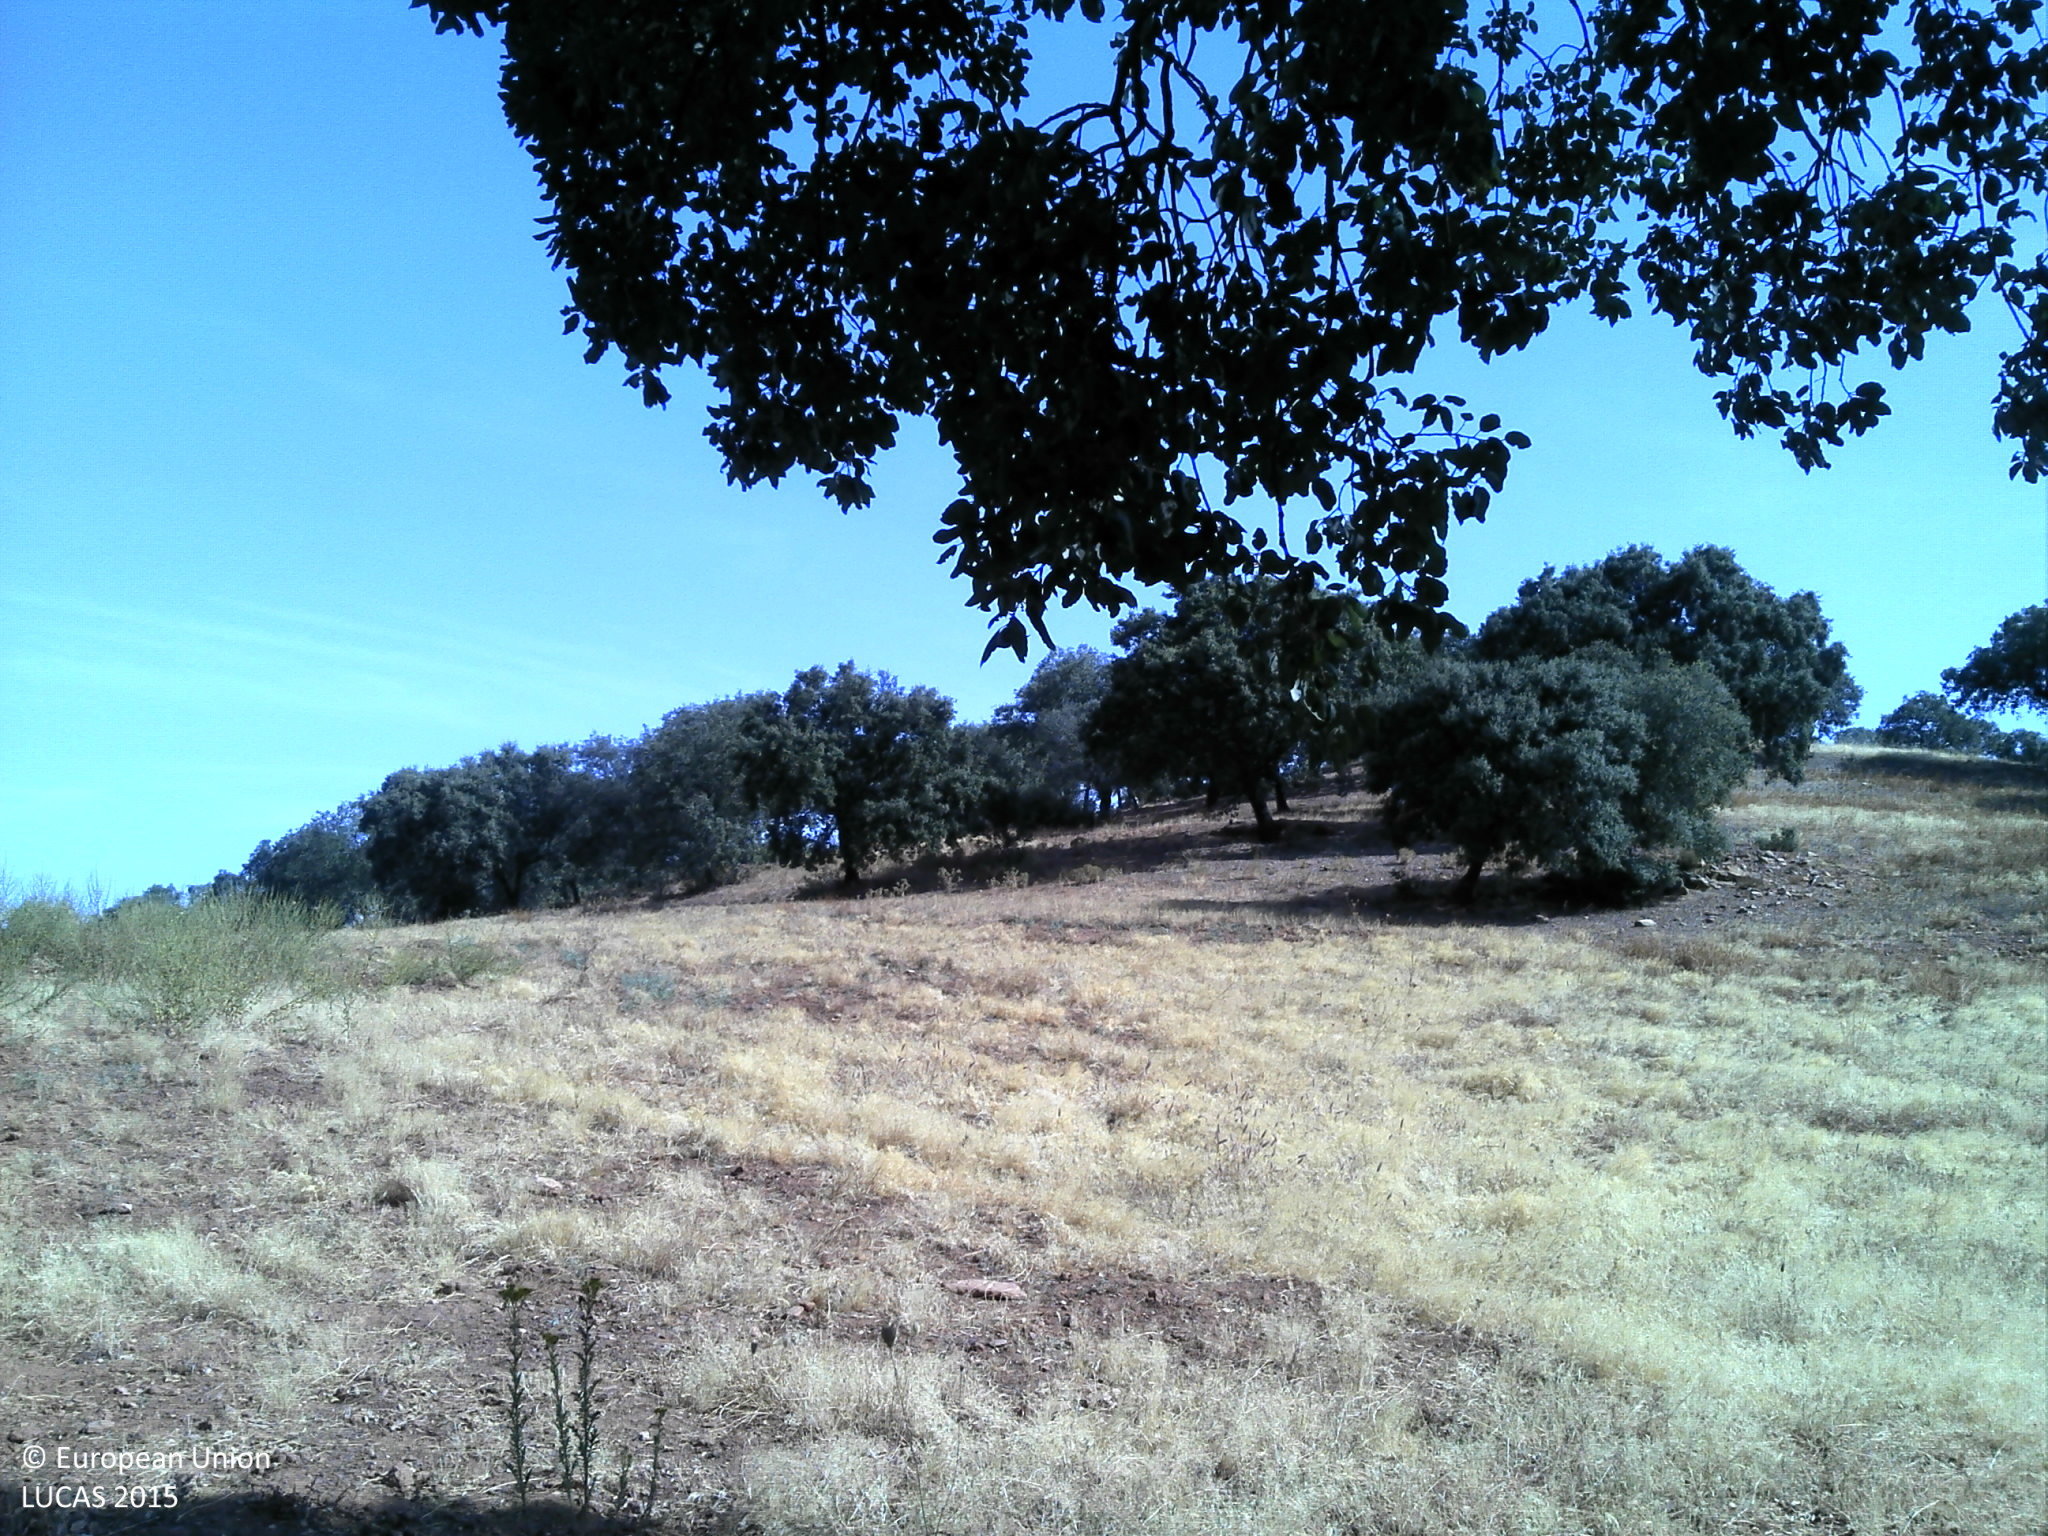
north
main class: Woodland
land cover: Broadleaved woodland
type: broadleaved evergreen forest
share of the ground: 10 - 25 %
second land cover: Spontaneously vegetated surfaces
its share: 10 - 25 %
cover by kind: unconsolidated bare surface 80 %, broadleaved forest trees 10 %, herbaceous plants 10 %
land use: Forestry
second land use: Agriculture (excluding fallow land and kitchen gardens)
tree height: > 5 m
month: July
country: PT
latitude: 38.3337
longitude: -7.7754
